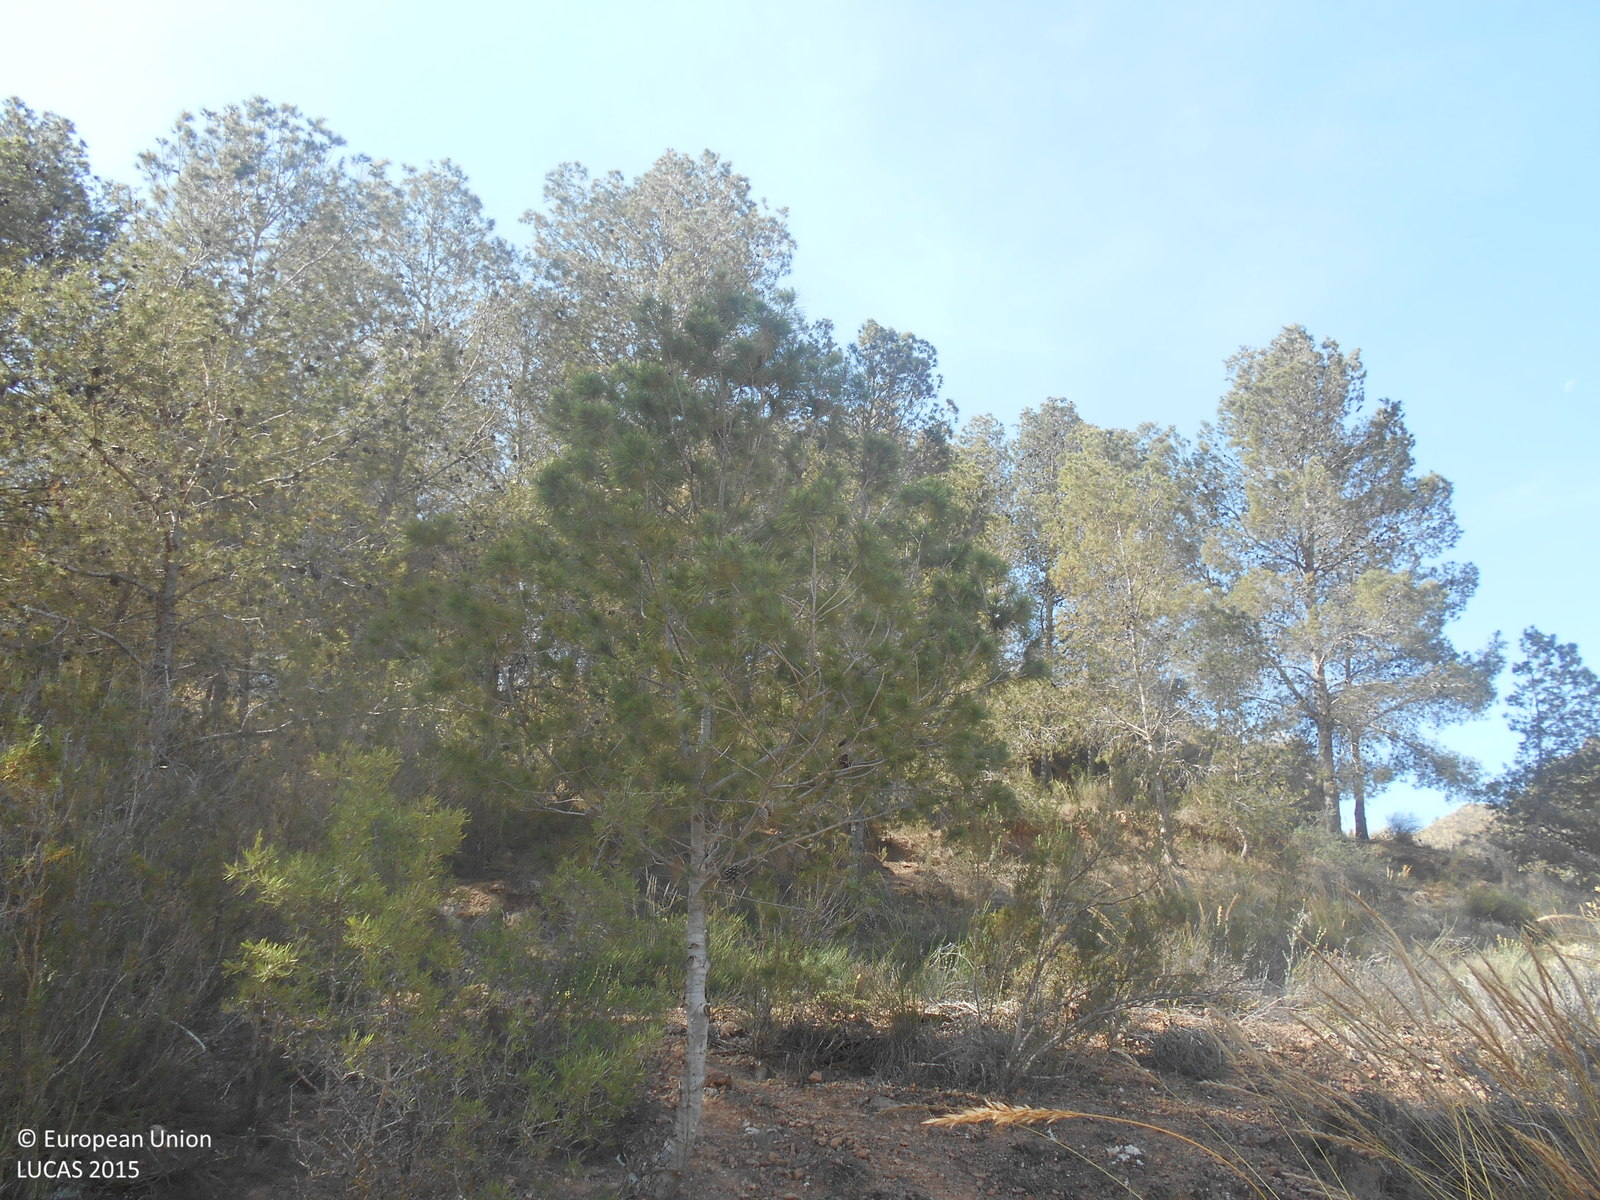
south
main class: Woodland
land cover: Pine dominated coniferous woodland
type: coniferous forest of the mediterranean region
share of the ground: 10 - 25 %
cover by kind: shrubs 60 %, coniferous forest trees 20 %, herbaceous plants 10 %, unconsolidated bare surface 10 %
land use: Semi-natural and natural areas not in use
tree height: > 5 m
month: May
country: ES
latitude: 37.6046
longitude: -1.4323
